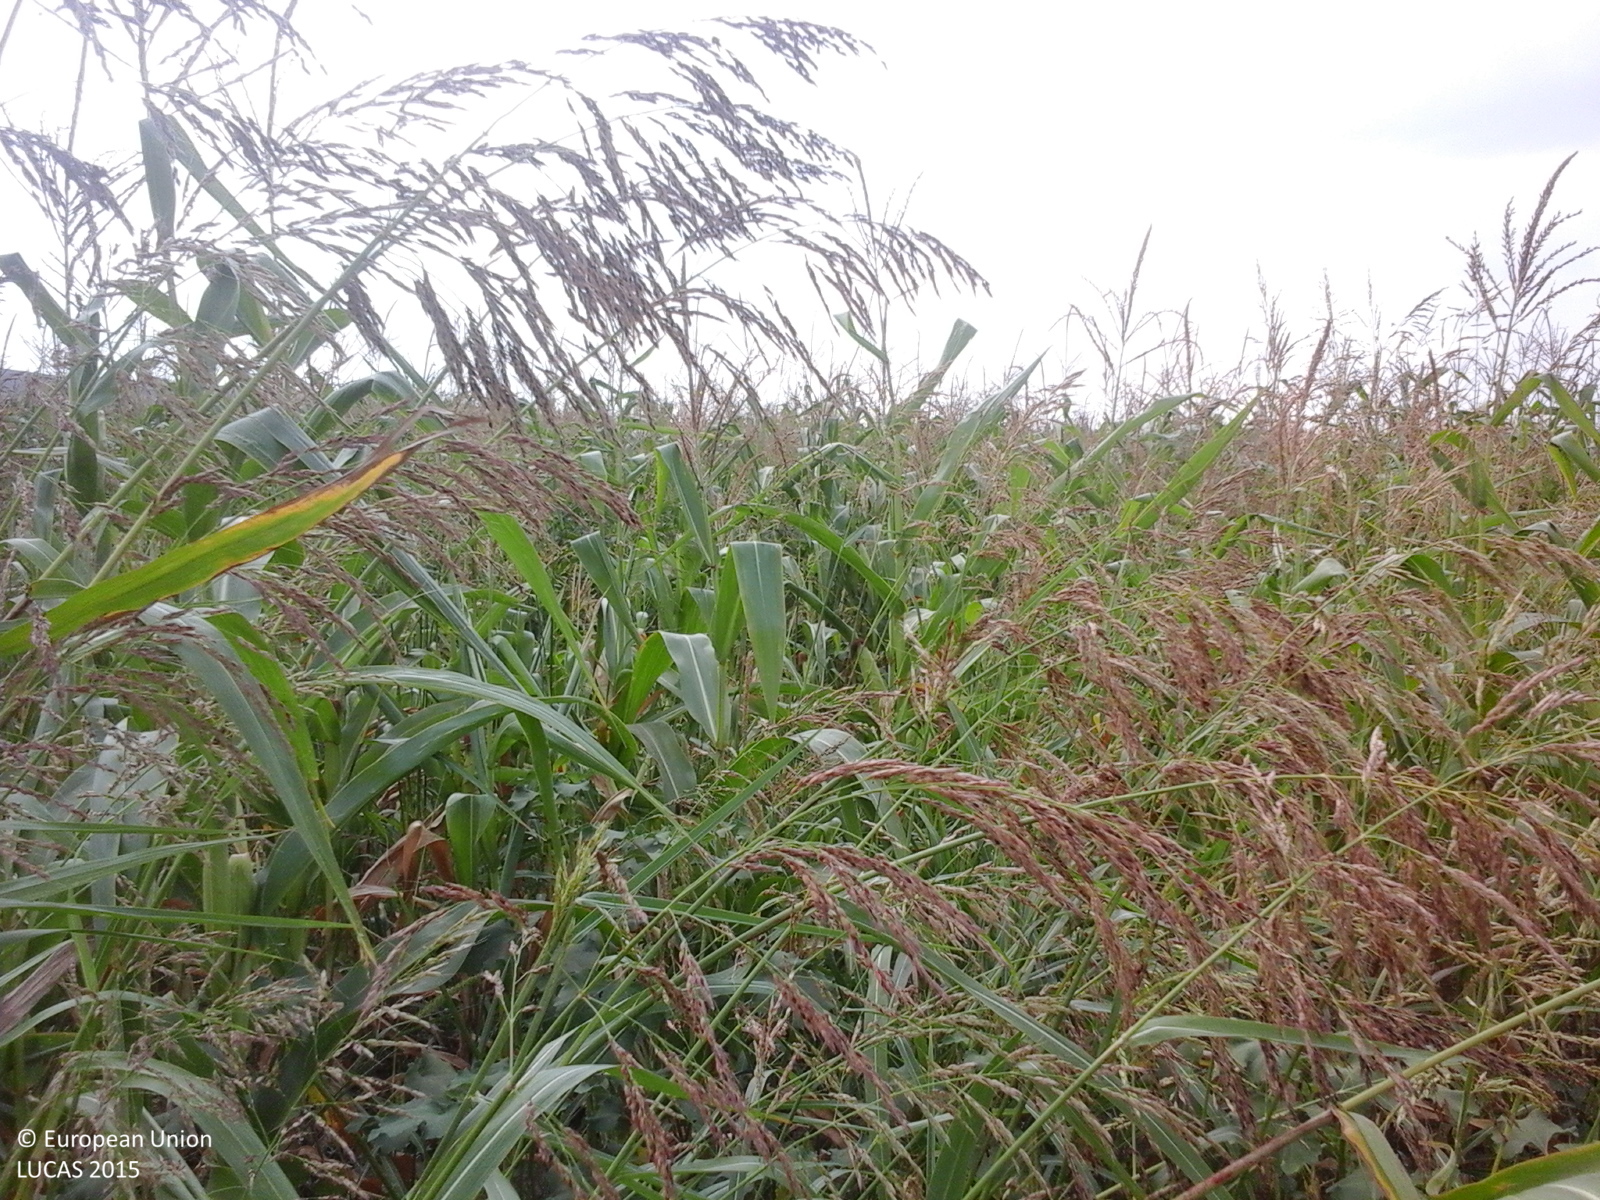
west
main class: Cropland
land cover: Maize
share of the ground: > 75 %
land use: Agriculture (excluding fallow land and kitchen gardens)
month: July
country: RO
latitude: 45.0152
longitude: 28.7001
